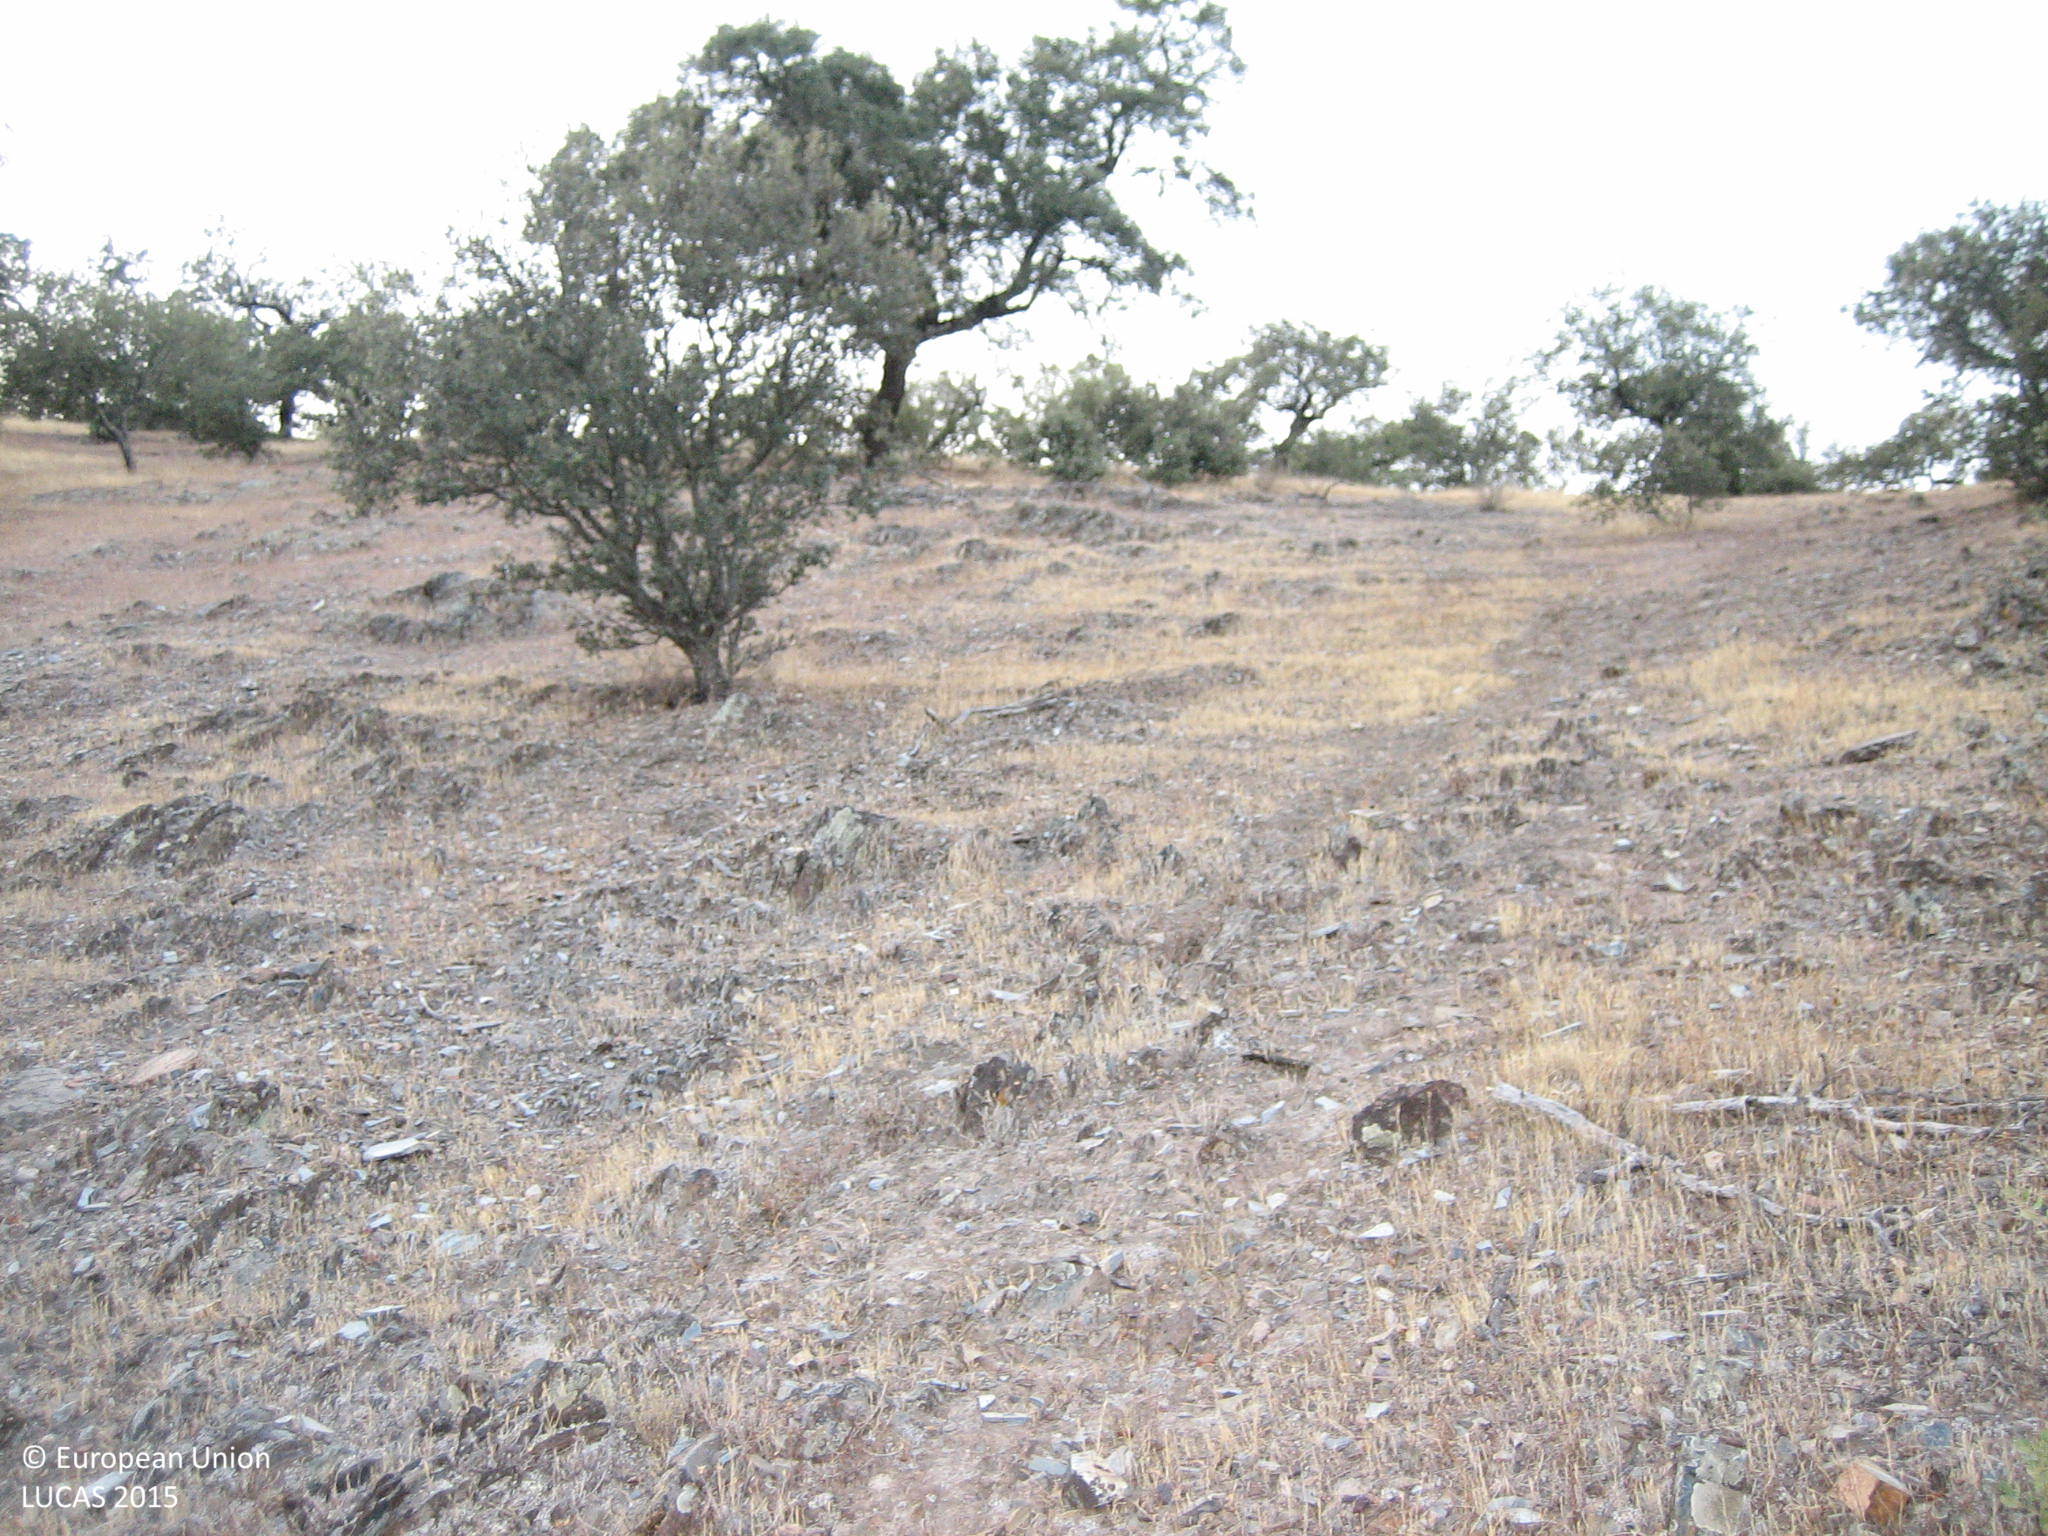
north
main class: Woodland
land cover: Broadleaved woodland
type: broadleaved evergreen forest
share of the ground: 10 - 25 %
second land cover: Shrubland without tree cover
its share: 10 - 25 %
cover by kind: herbaceous plants 40 %, broadleaved forest trees 20 %, shrubs 20 %, unconsolidated bare surface 20 %
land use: Forestry
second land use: Agriculture (excluding fallow land and kitchen gardens)
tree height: < 5 m
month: September
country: ES
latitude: 38.3610
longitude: -7.1271
